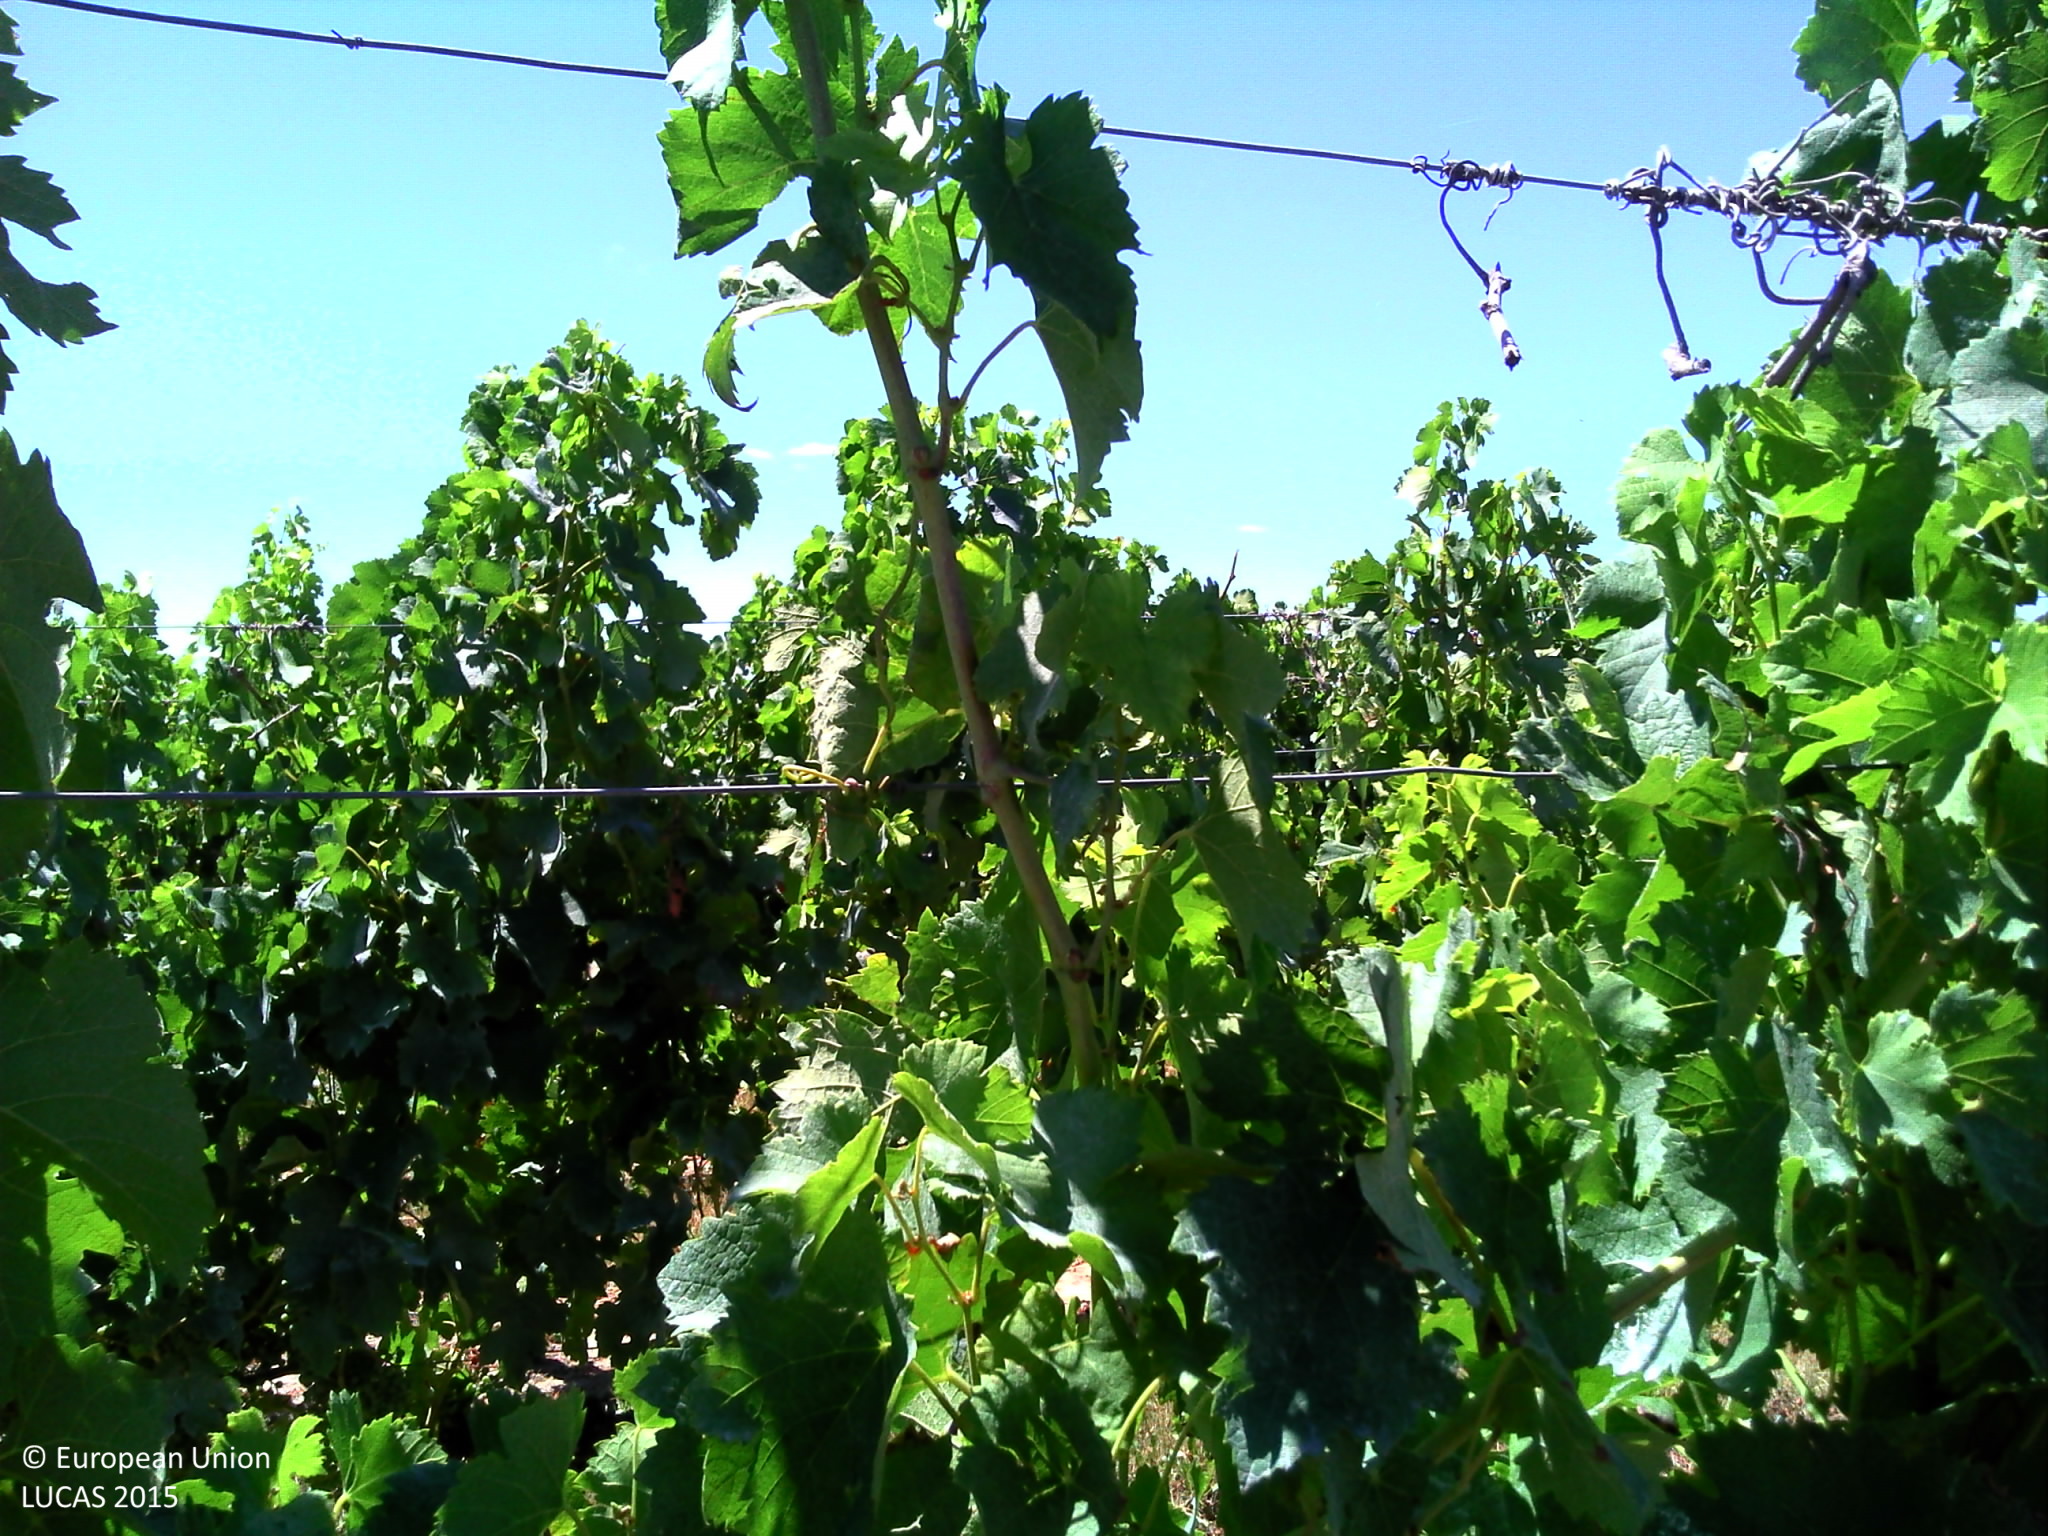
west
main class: Cropland
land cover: Vineyards
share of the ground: 25 - 50 %
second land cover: Grassland without tree/shrub cover
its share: > 75 %
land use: Agriculture (excluding fallow land and kitchen gardens)
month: July
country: FR
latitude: 44.8205
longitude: 0.4929
